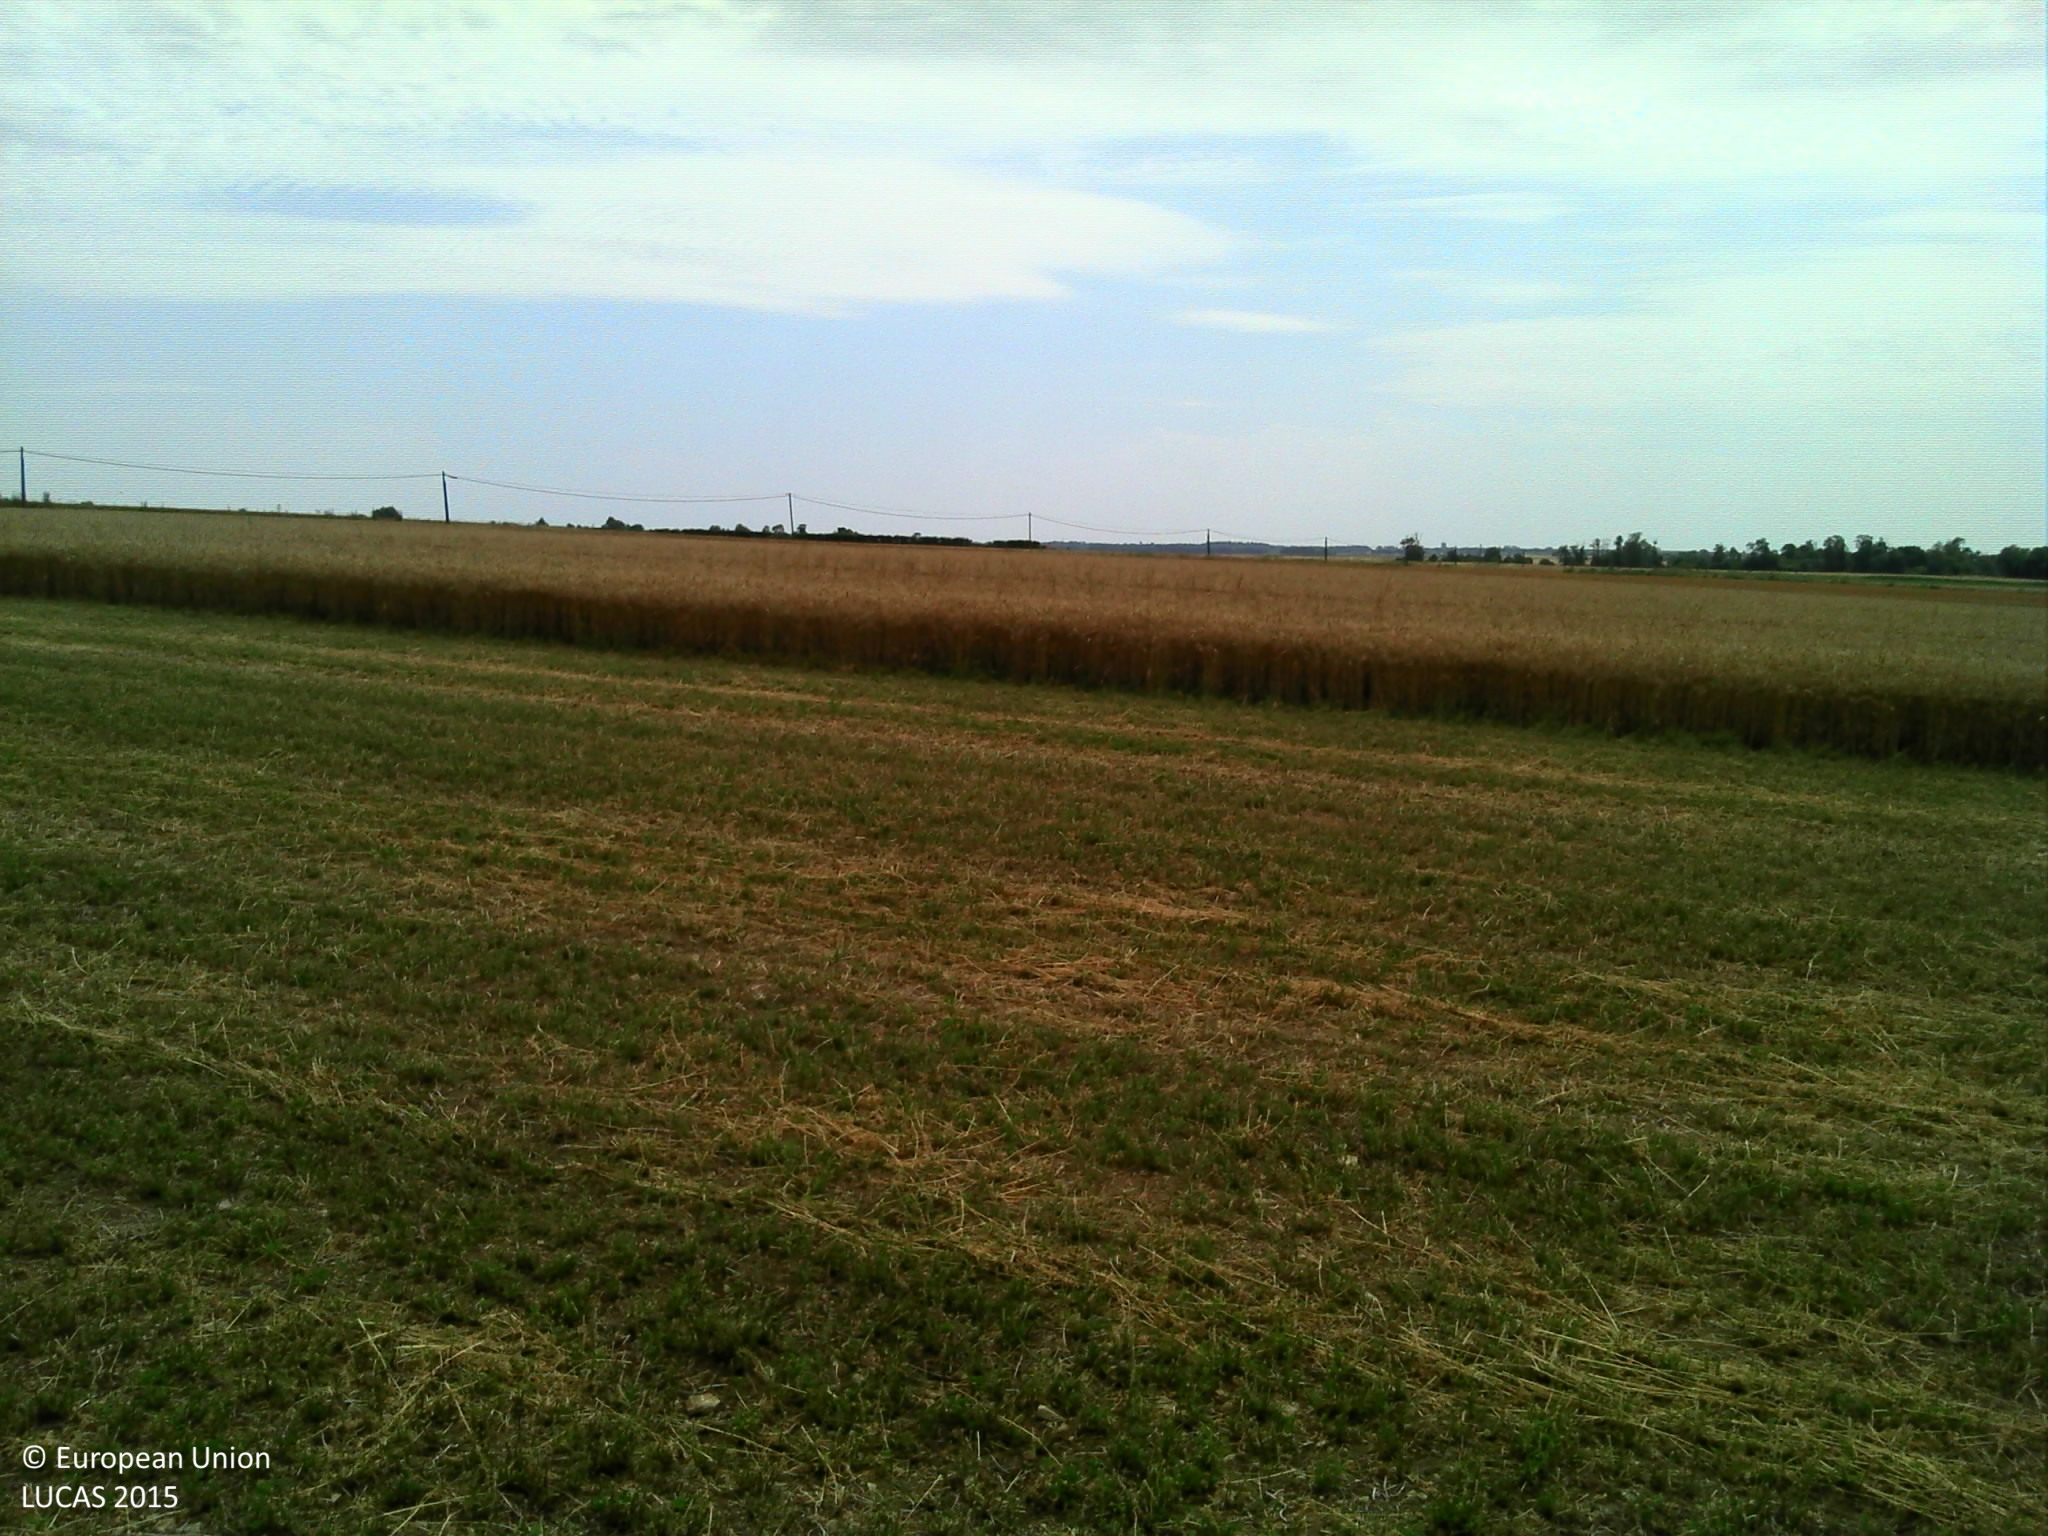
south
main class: Cropland
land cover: Lucerne
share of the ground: < 10 %
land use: Agriculture (excluding fallow land and kitchen gardens)
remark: Harvested field
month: July
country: FR
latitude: 49.0523
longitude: -0.2272
